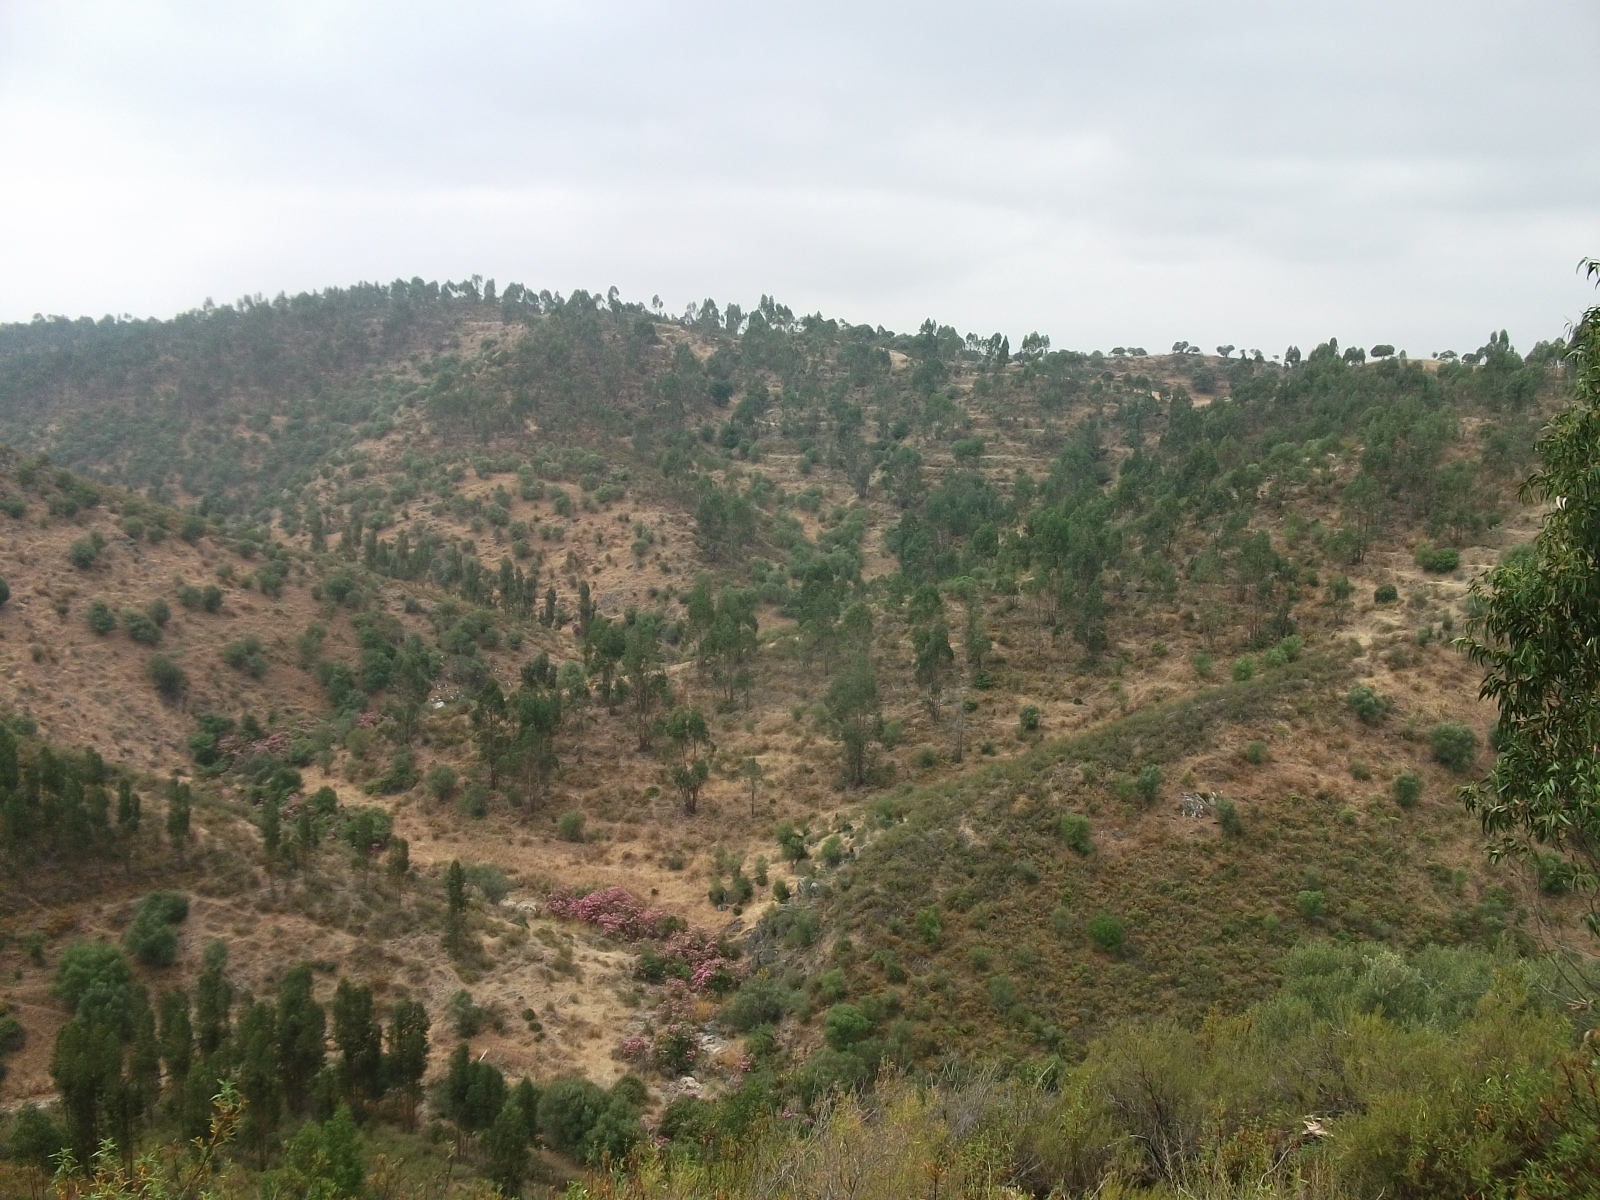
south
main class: Woodland
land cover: Broadleaved woodland
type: exotic forest
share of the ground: 10 - 25 %
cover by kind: shrubs 65 %, broadleaved forest trees 25 %, herbaceous plants 10 %
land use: Forestry
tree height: > 5 m
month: June
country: ES
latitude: 37.4923
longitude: -6.9290
